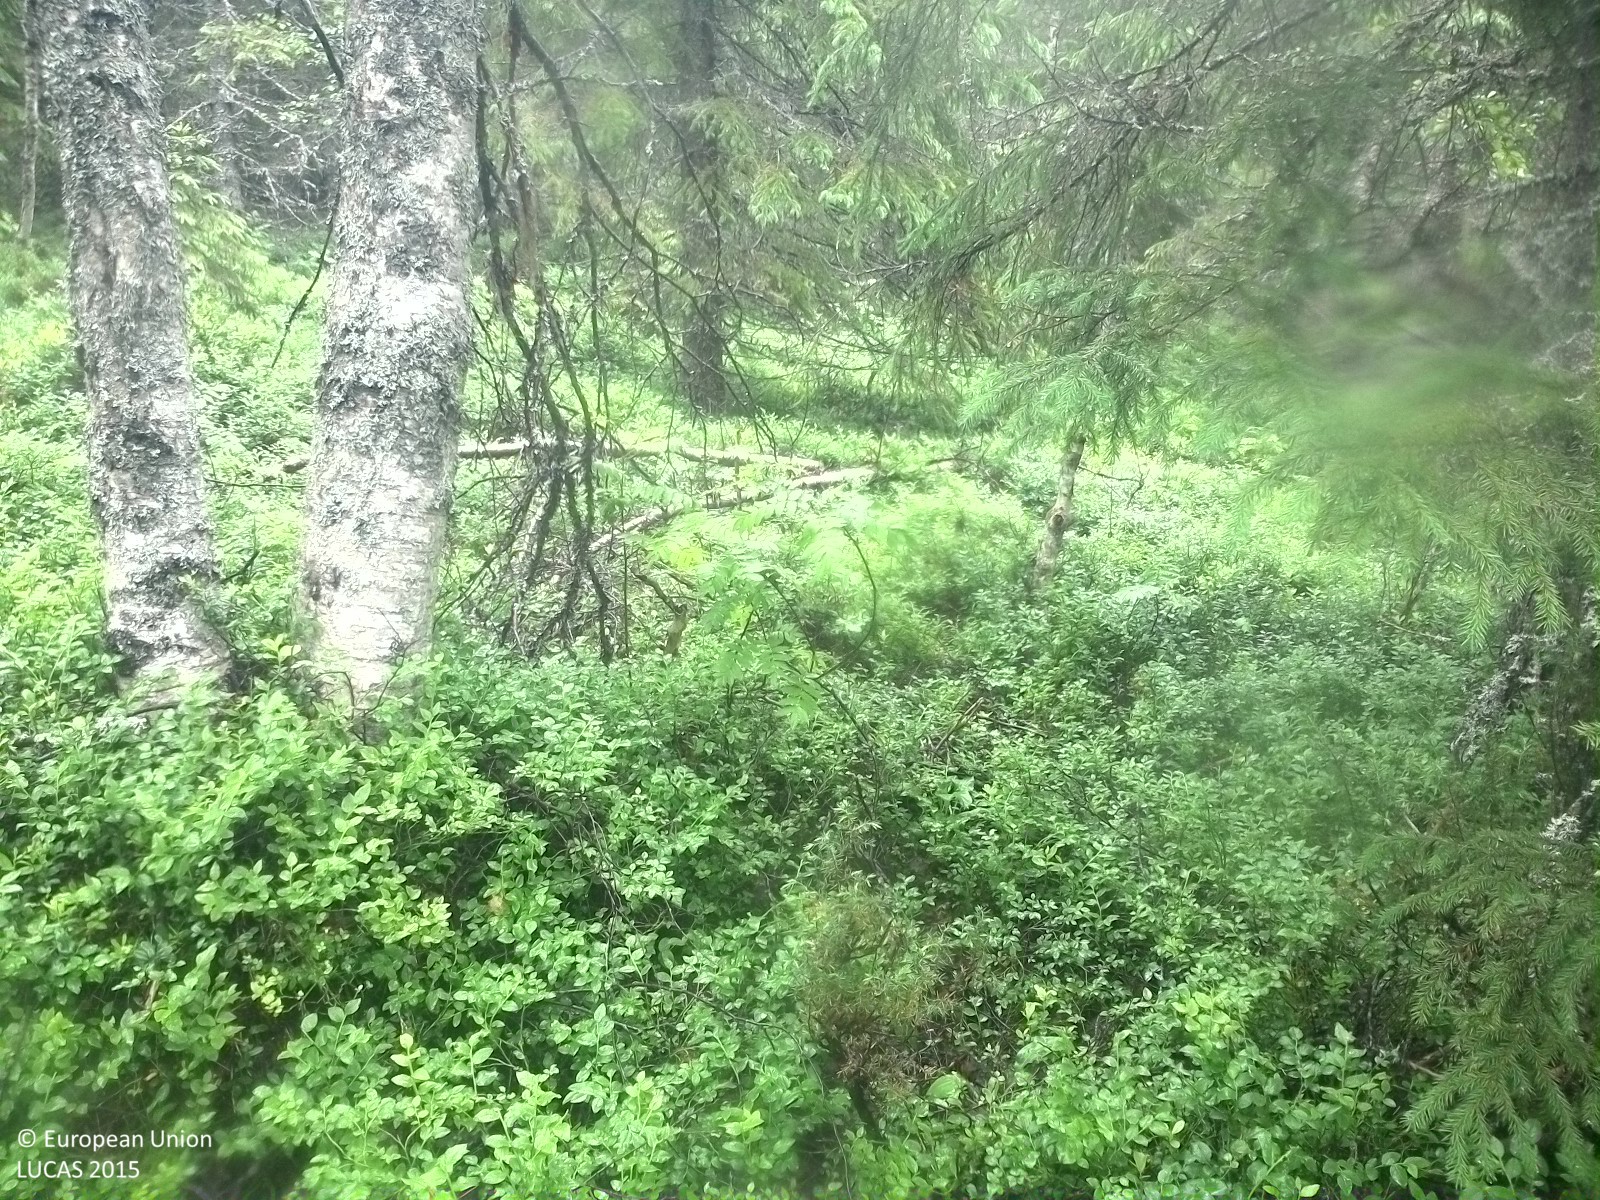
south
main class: Woodland
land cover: Spruce dominated mixed woodland
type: boreal forest
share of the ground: 25 - 50 %
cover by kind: shrubs 50 %, coniferous forest trees 35 %, broadleaved forest trees 15 %
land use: Forestry
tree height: > 5 m
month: July
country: SE
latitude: 62.4721
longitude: 16.9033
